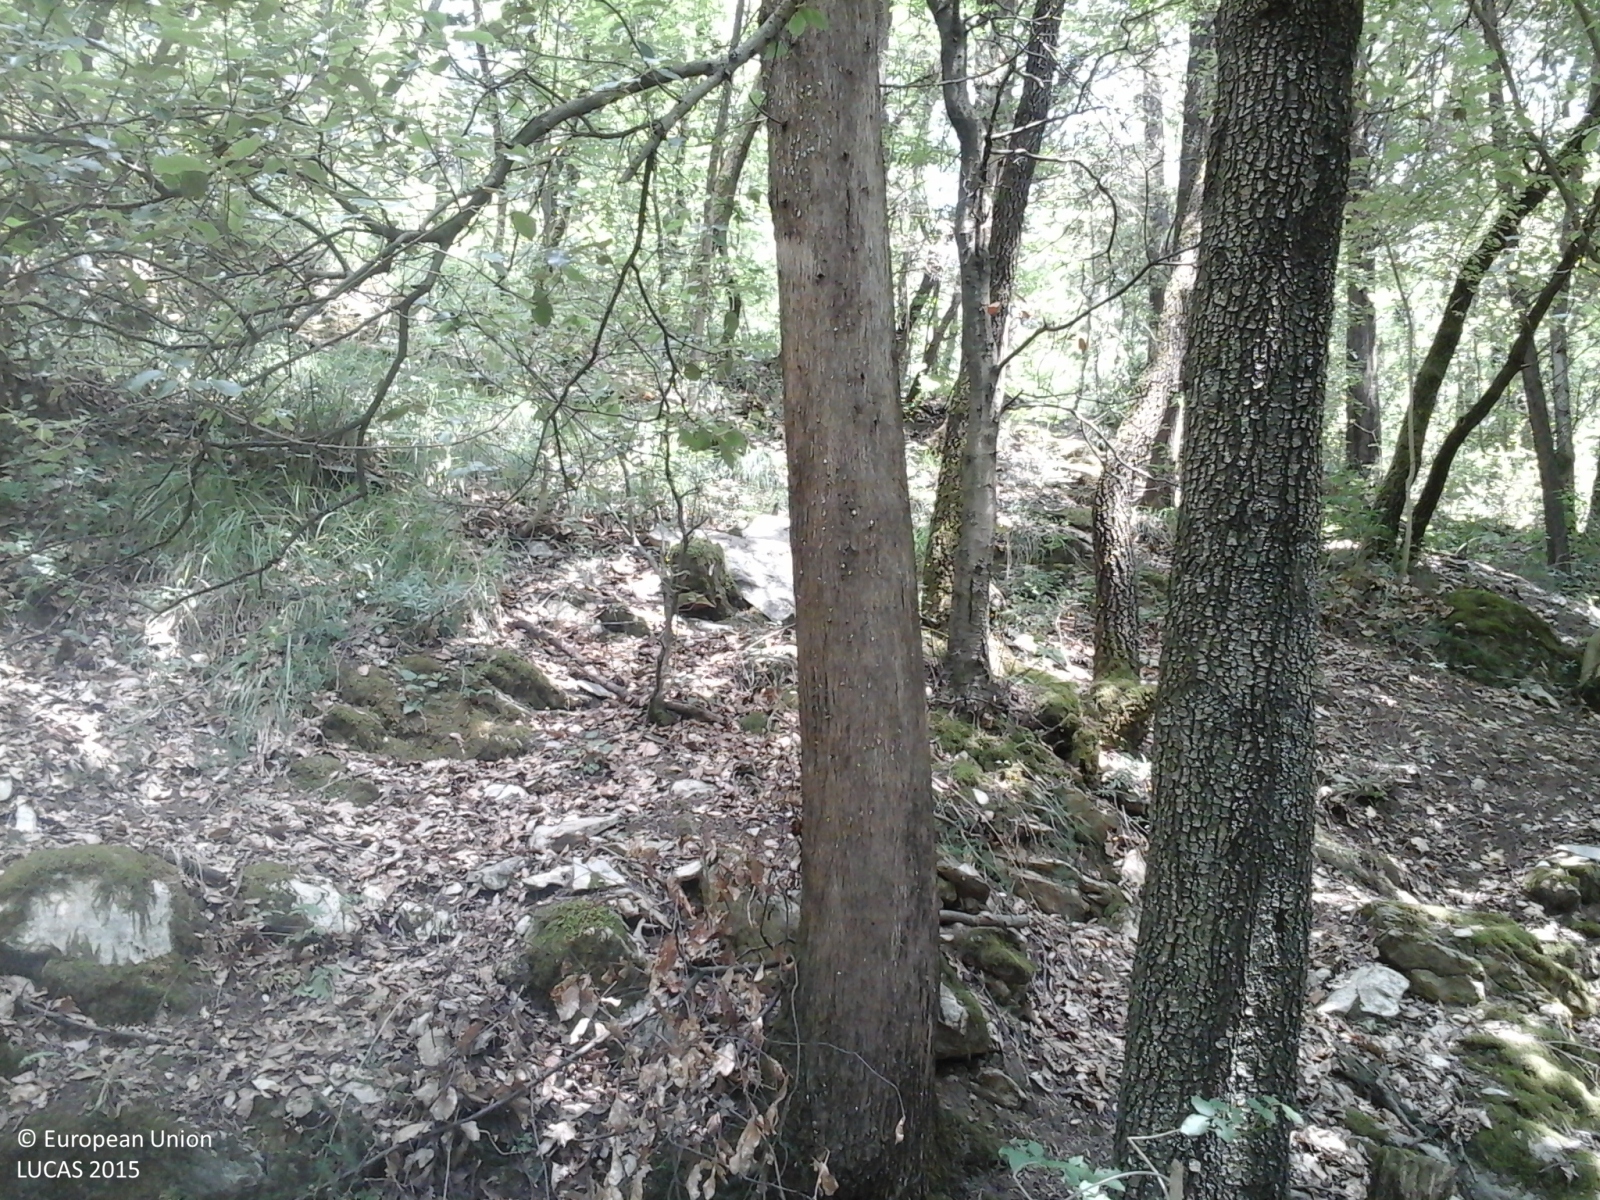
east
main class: Woodland
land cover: Other mixed woodland
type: thermophilous deciduous forest
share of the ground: > 75 %
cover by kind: broadleaved forest trees 75 %, coniferous forest trees 25 %
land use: Forestry
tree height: > 5 m
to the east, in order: Other mixed woodland; Tracks; Other mixed woodland; Tracks; Other mixed woodland; Tracks; Broadleaved woodland
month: June
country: IT
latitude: 43.9303
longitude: 11.0561
